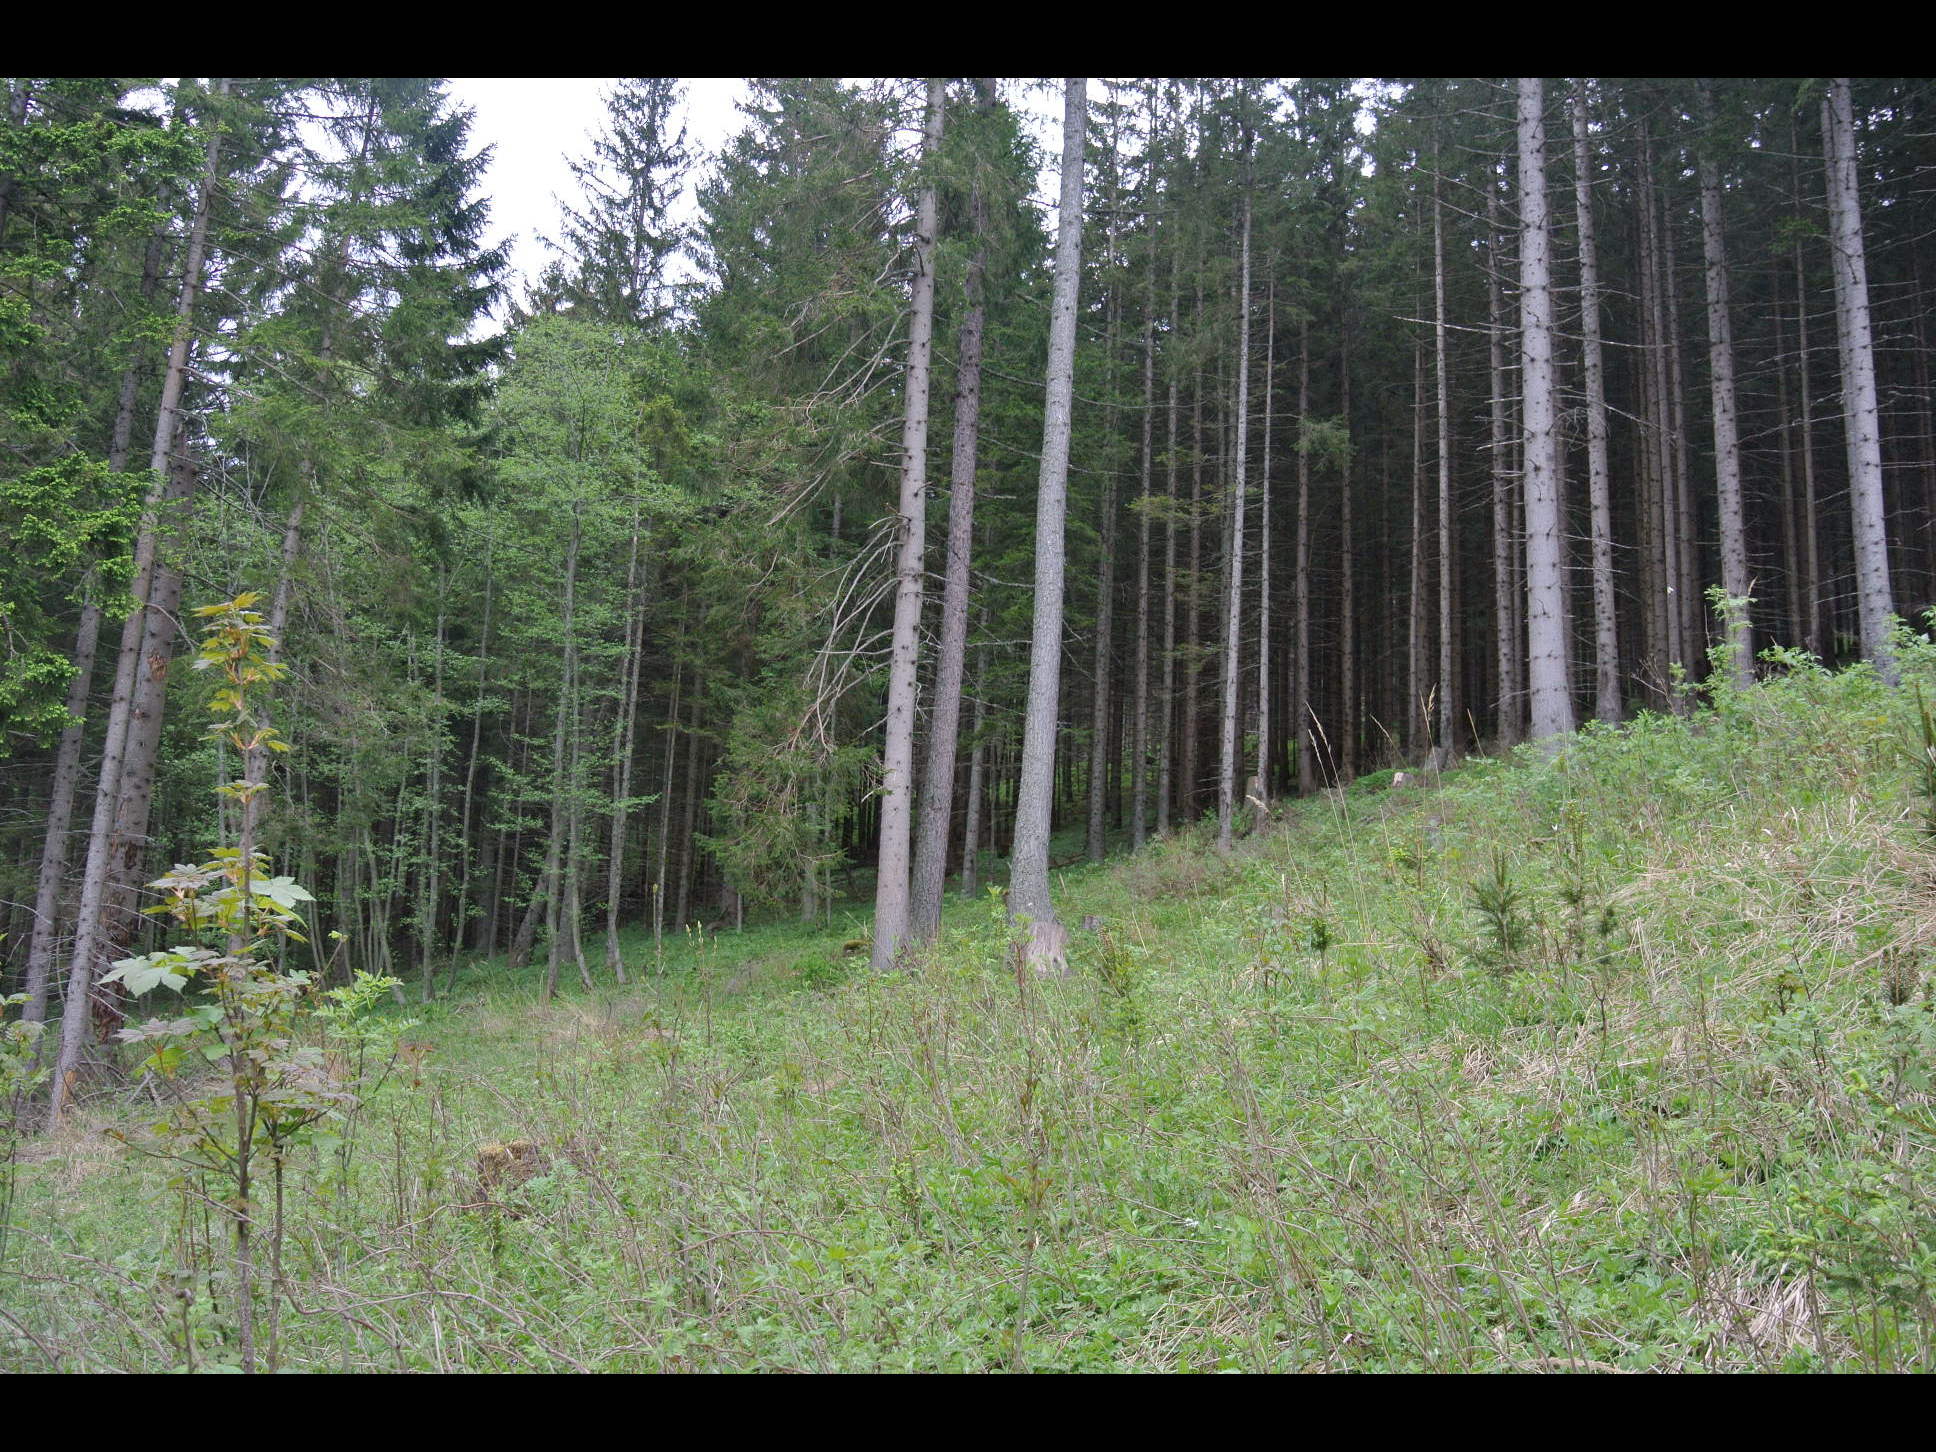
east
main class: Shrubland
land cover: Shrubland with sparse tree cover
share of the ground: > 75 %
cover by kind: shrubs 75 %, herbaceous plants 20 %, broadleaved forest trees 5 %
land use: Forestry
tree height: < 5 m
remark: Clear cut
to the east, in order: Shrubland with sparse tree cover; Spruce dominated coniferous woodland; Tracks; Spruce dominated coniferous woodland; Broadleaved woodland; Spruce dominated coniferous woodland; Broadleaved woodland
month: May
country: AT
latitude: 47.6604
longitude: 15.7142
